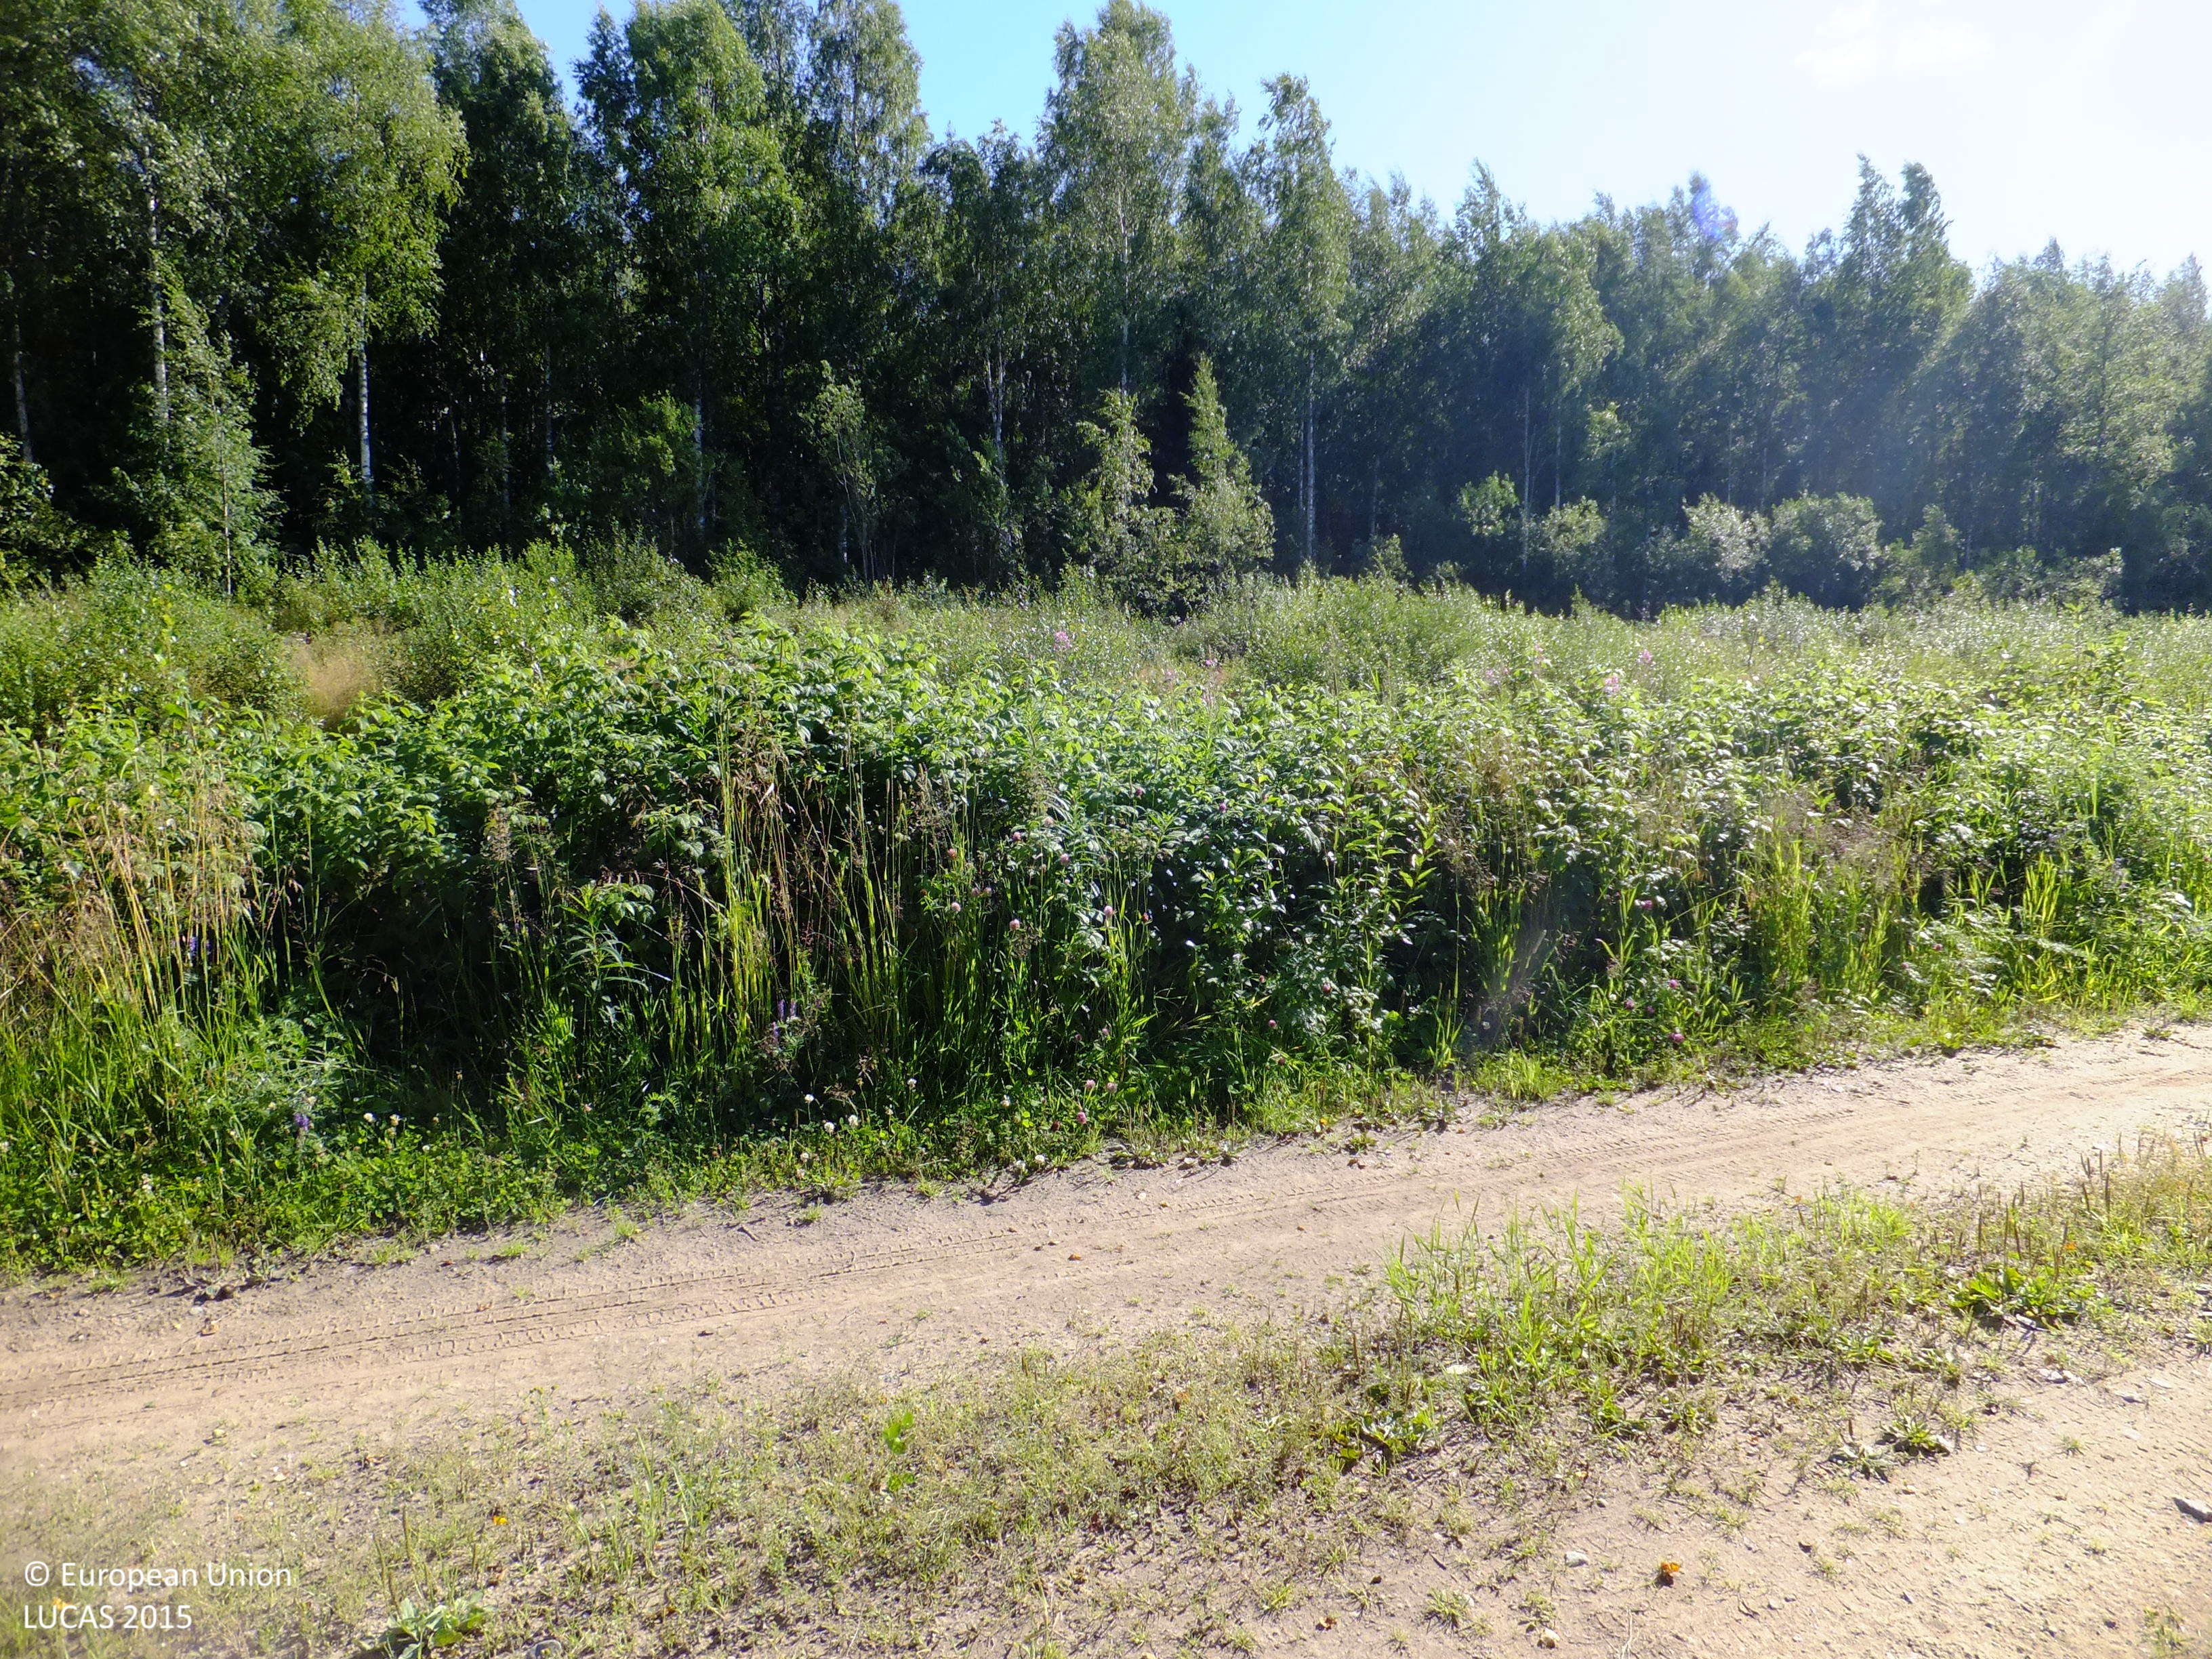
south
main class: Shrubland
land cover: Shrubland with sparse tree cover
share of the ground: > 75 %
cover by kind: shrubs 60 %, herbaceous plants 35 %, broadleaved forest trees 5 %
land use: Semi-natural and natural areas not in use
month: August
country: FI
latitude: 63.1335
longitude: 22.4863
